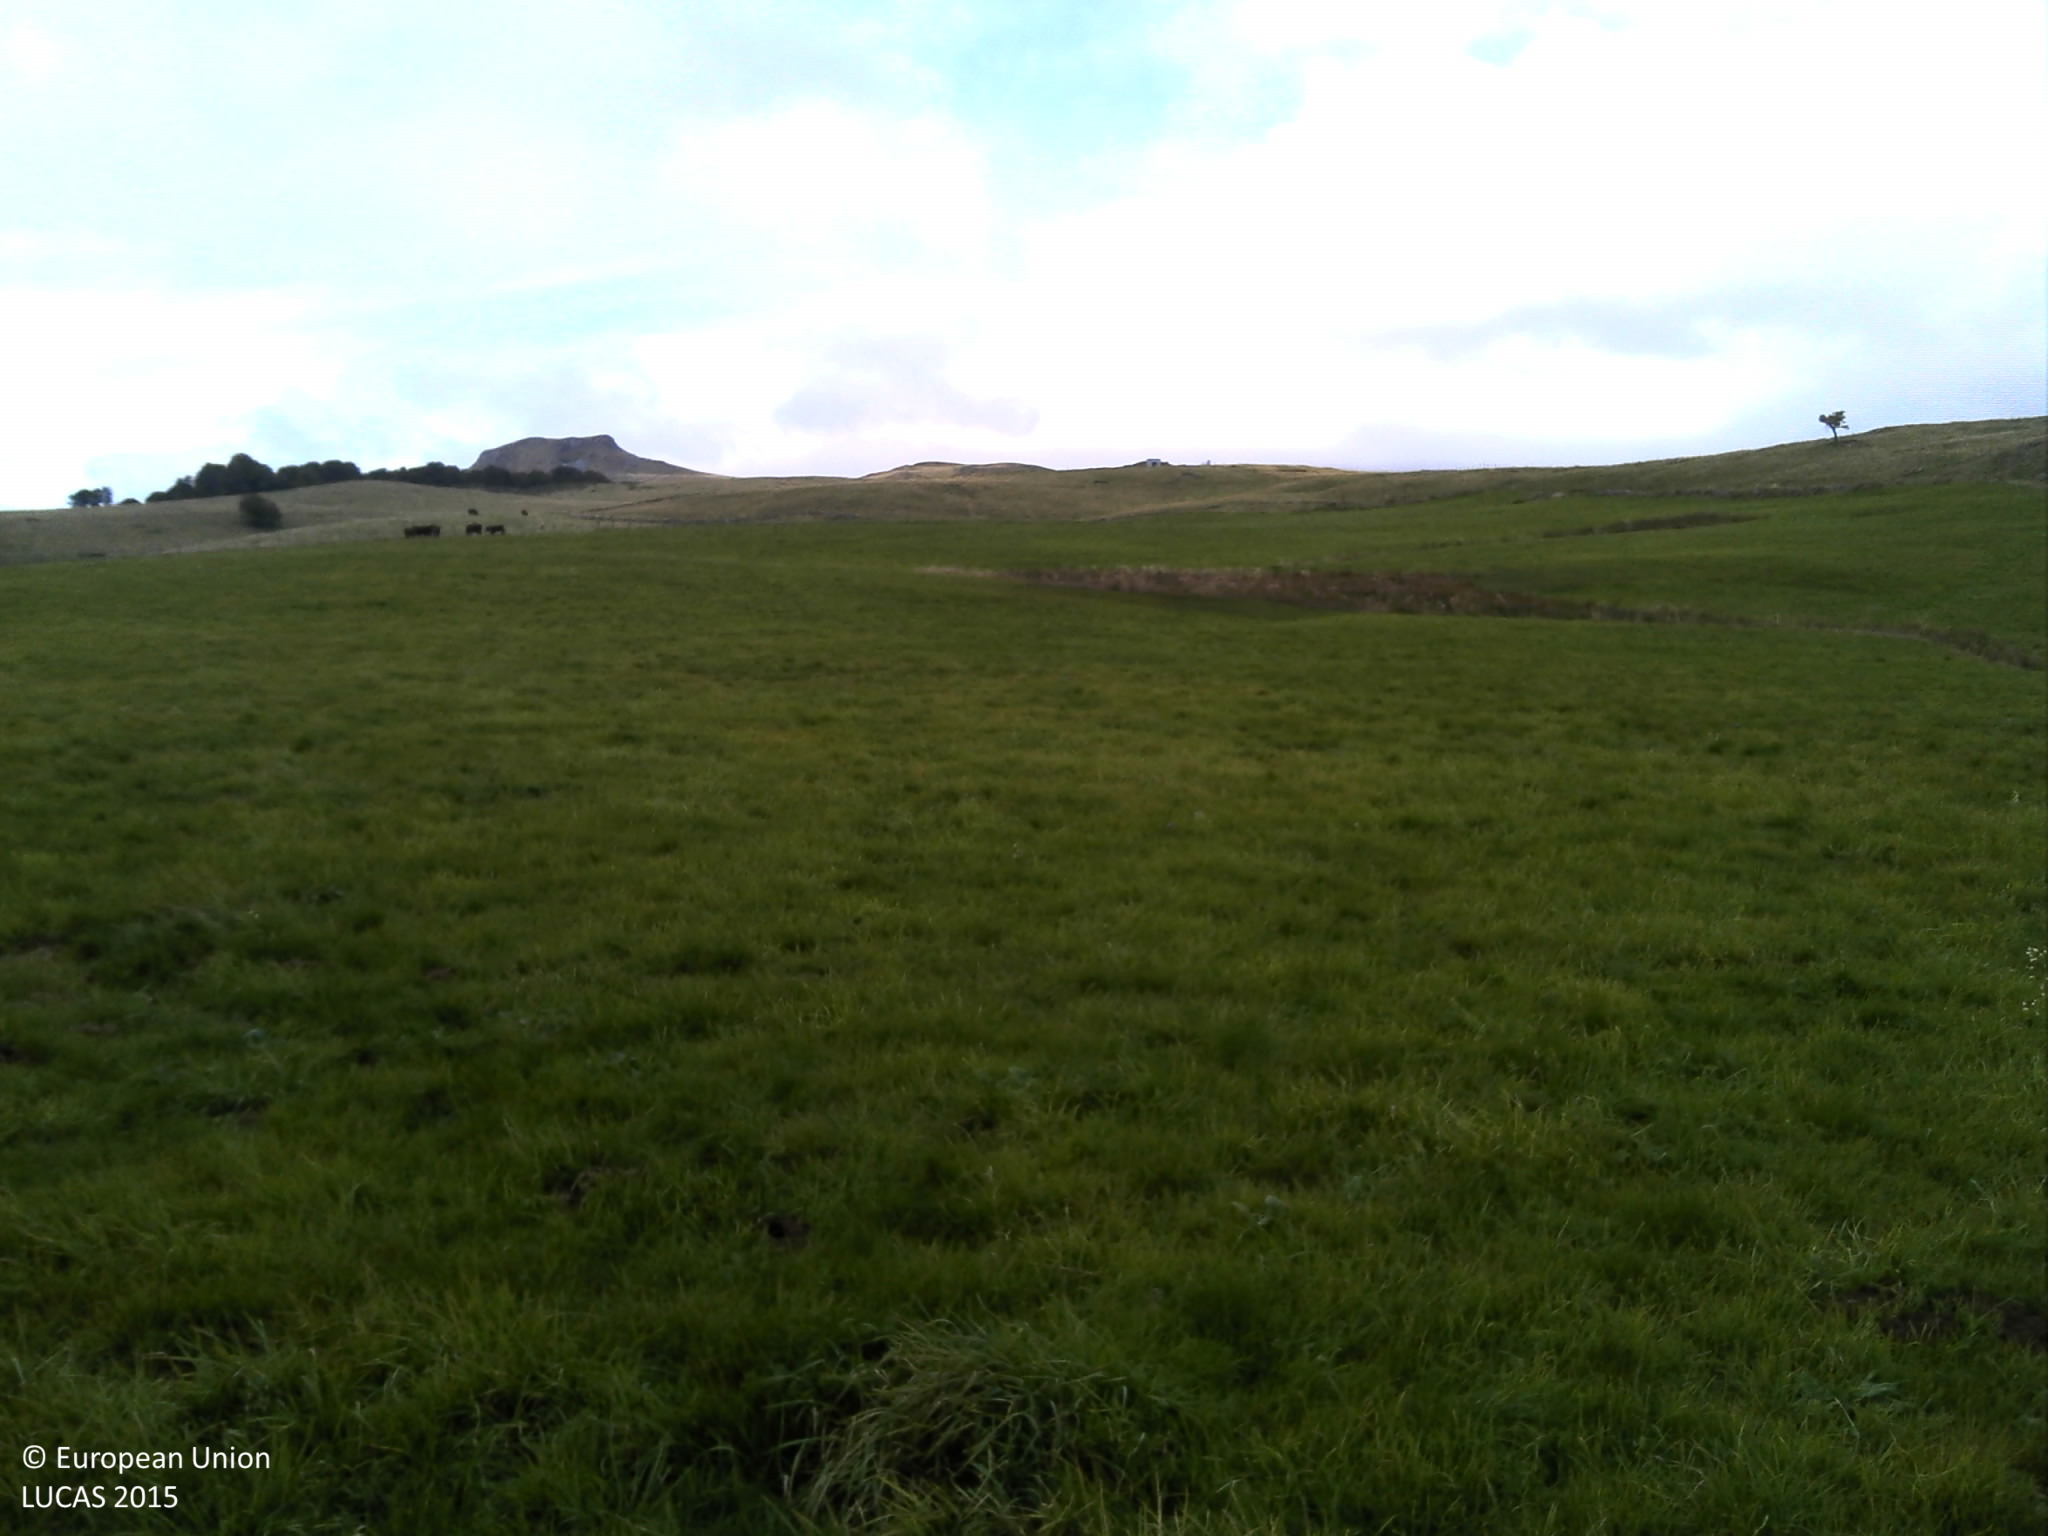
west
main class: Grassland
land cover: Grassland without tree/shrub cover
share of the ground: > 75 %
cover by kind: herbaceous plants 100 %
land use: Agriculture (excluding fallow land and kitchen gardens)
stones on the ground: < 10 %
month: September
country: FR
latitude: 45.5181
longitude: 2.8949
